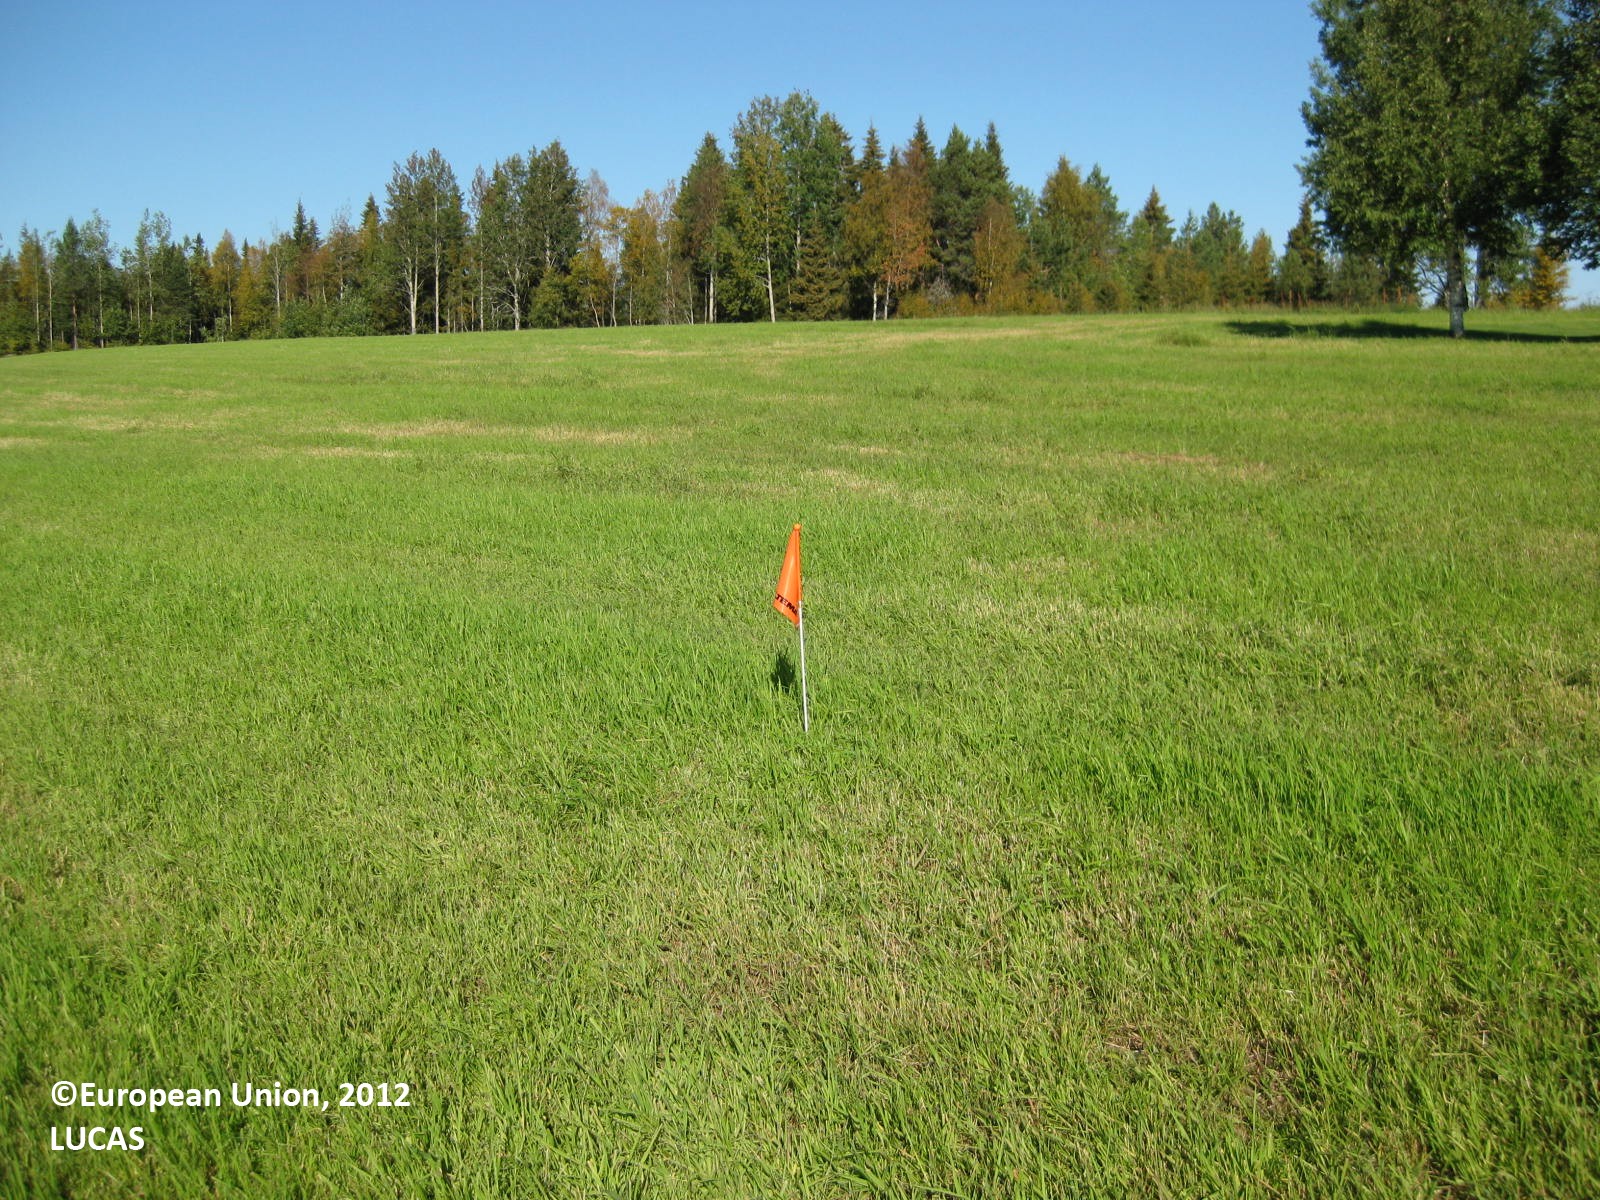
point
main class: Cropland
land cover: Temporary grasslands
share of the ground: > 75 %
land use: Agriculture (excluding fallow land and kitchen gardens)
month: August
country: FI
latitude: 66.0815
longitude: 29.6230
